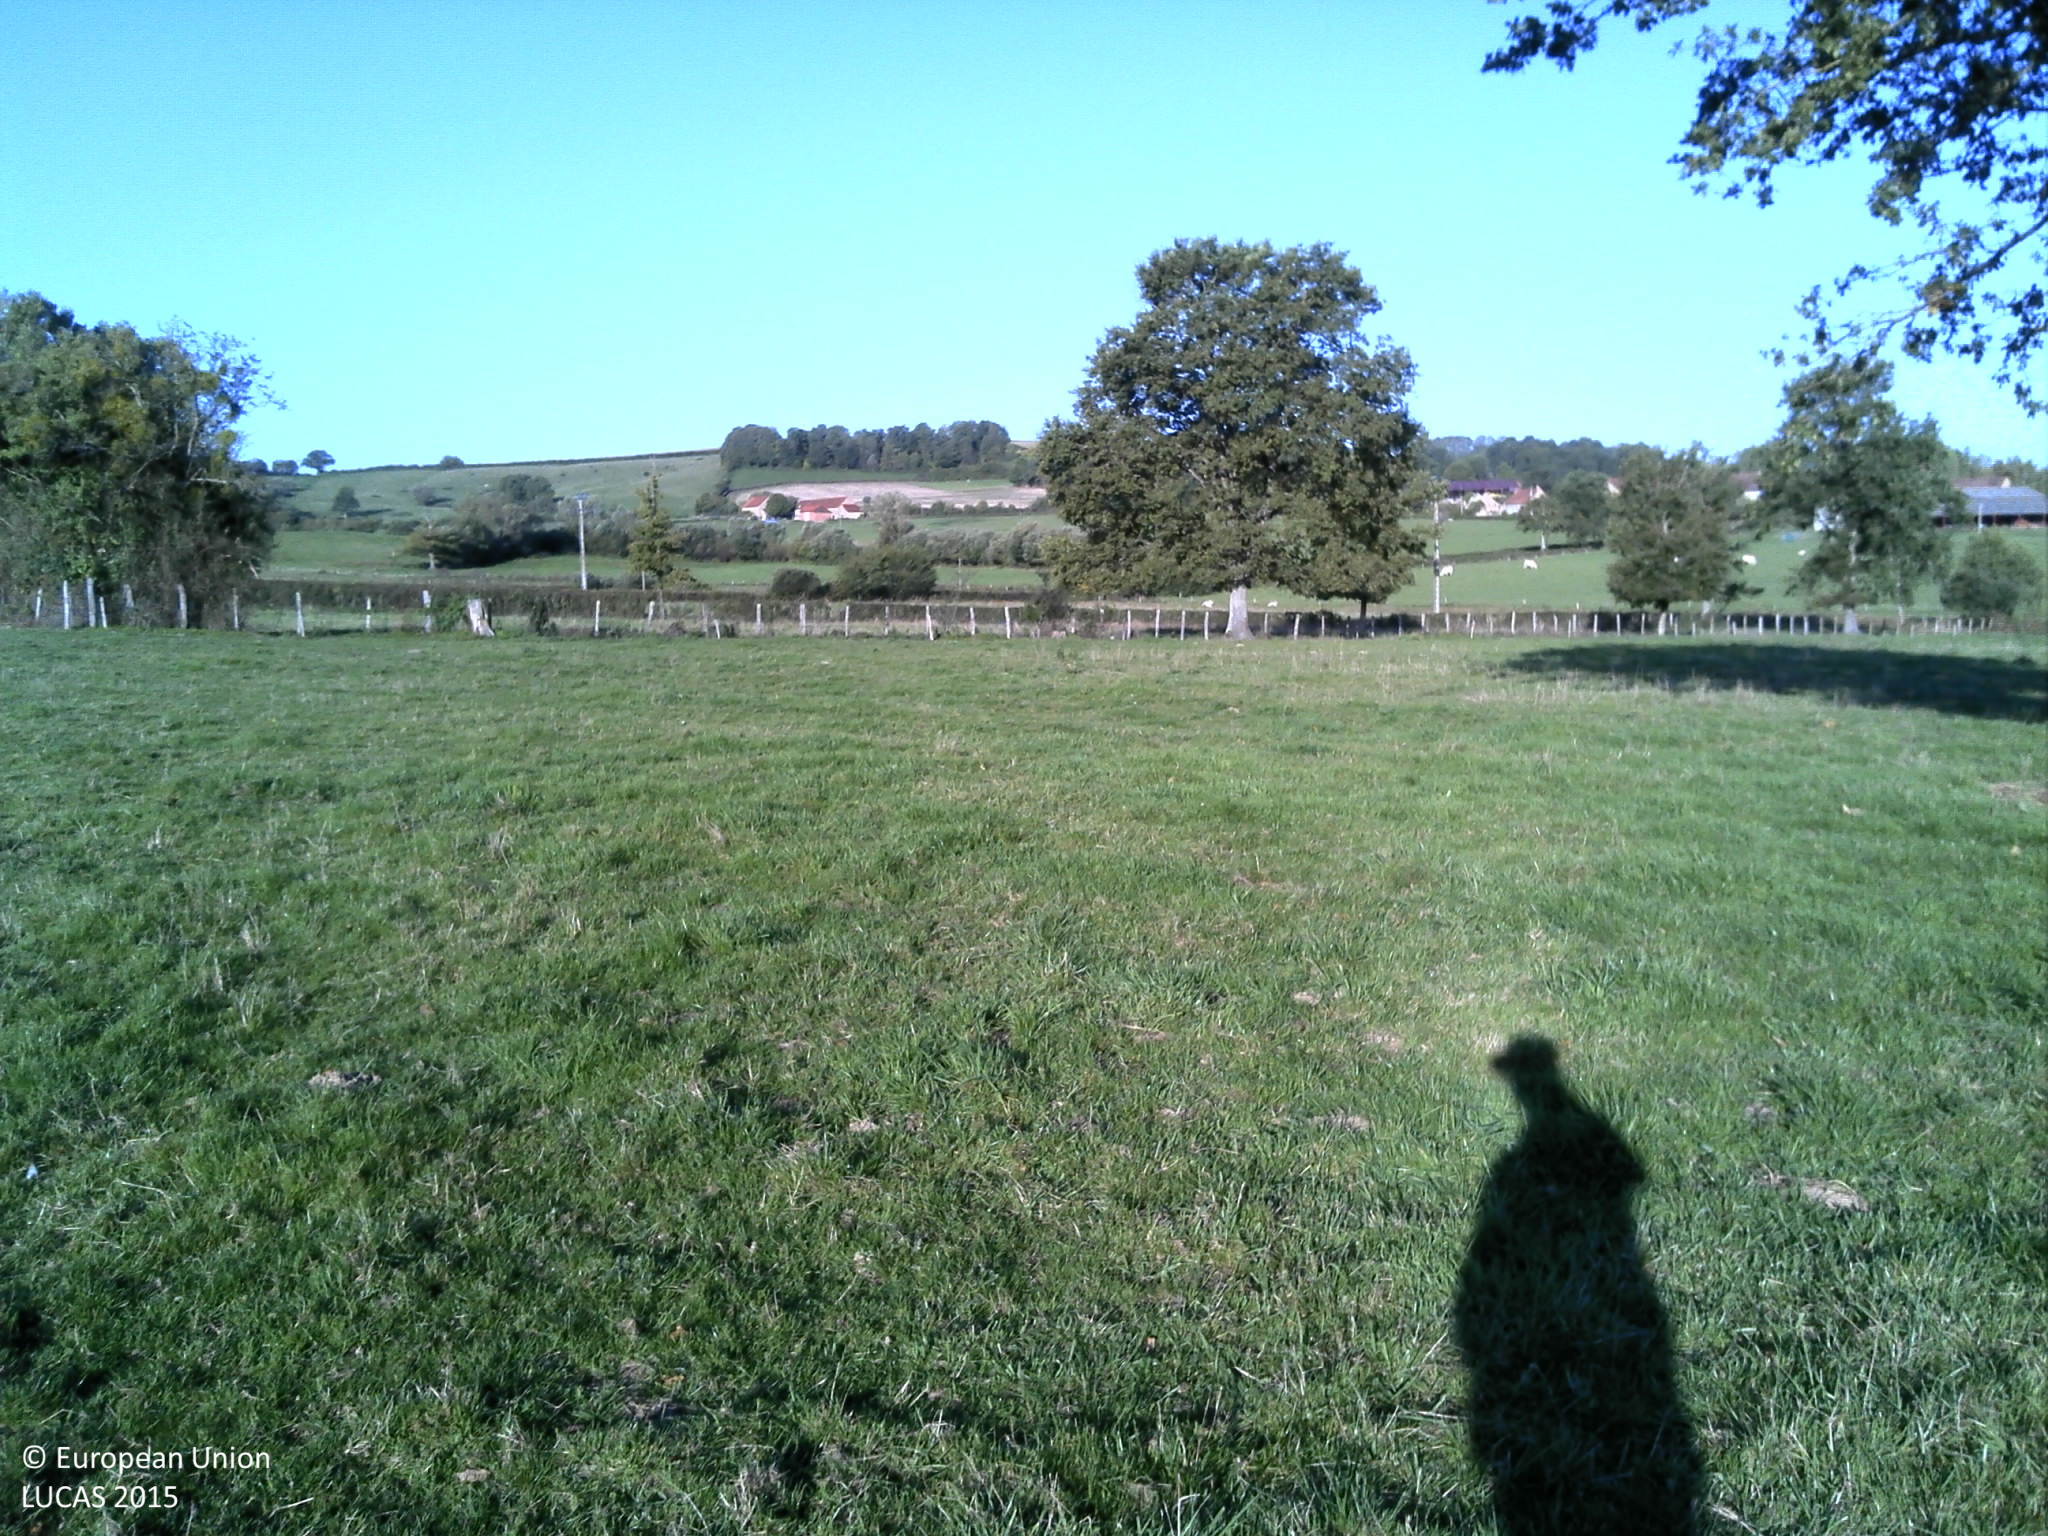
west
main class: Grassland
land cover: Grassland with sparse tree/shrub cover
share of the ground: > 75 %
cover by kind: herbaceous plants 95 %, broadleaved forest trees 5 %
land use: Agriculture (excluding fallow land and kitchen gardens)
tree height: > 5 m
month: September
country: FR
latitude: 46.9813
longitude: 4.4127
